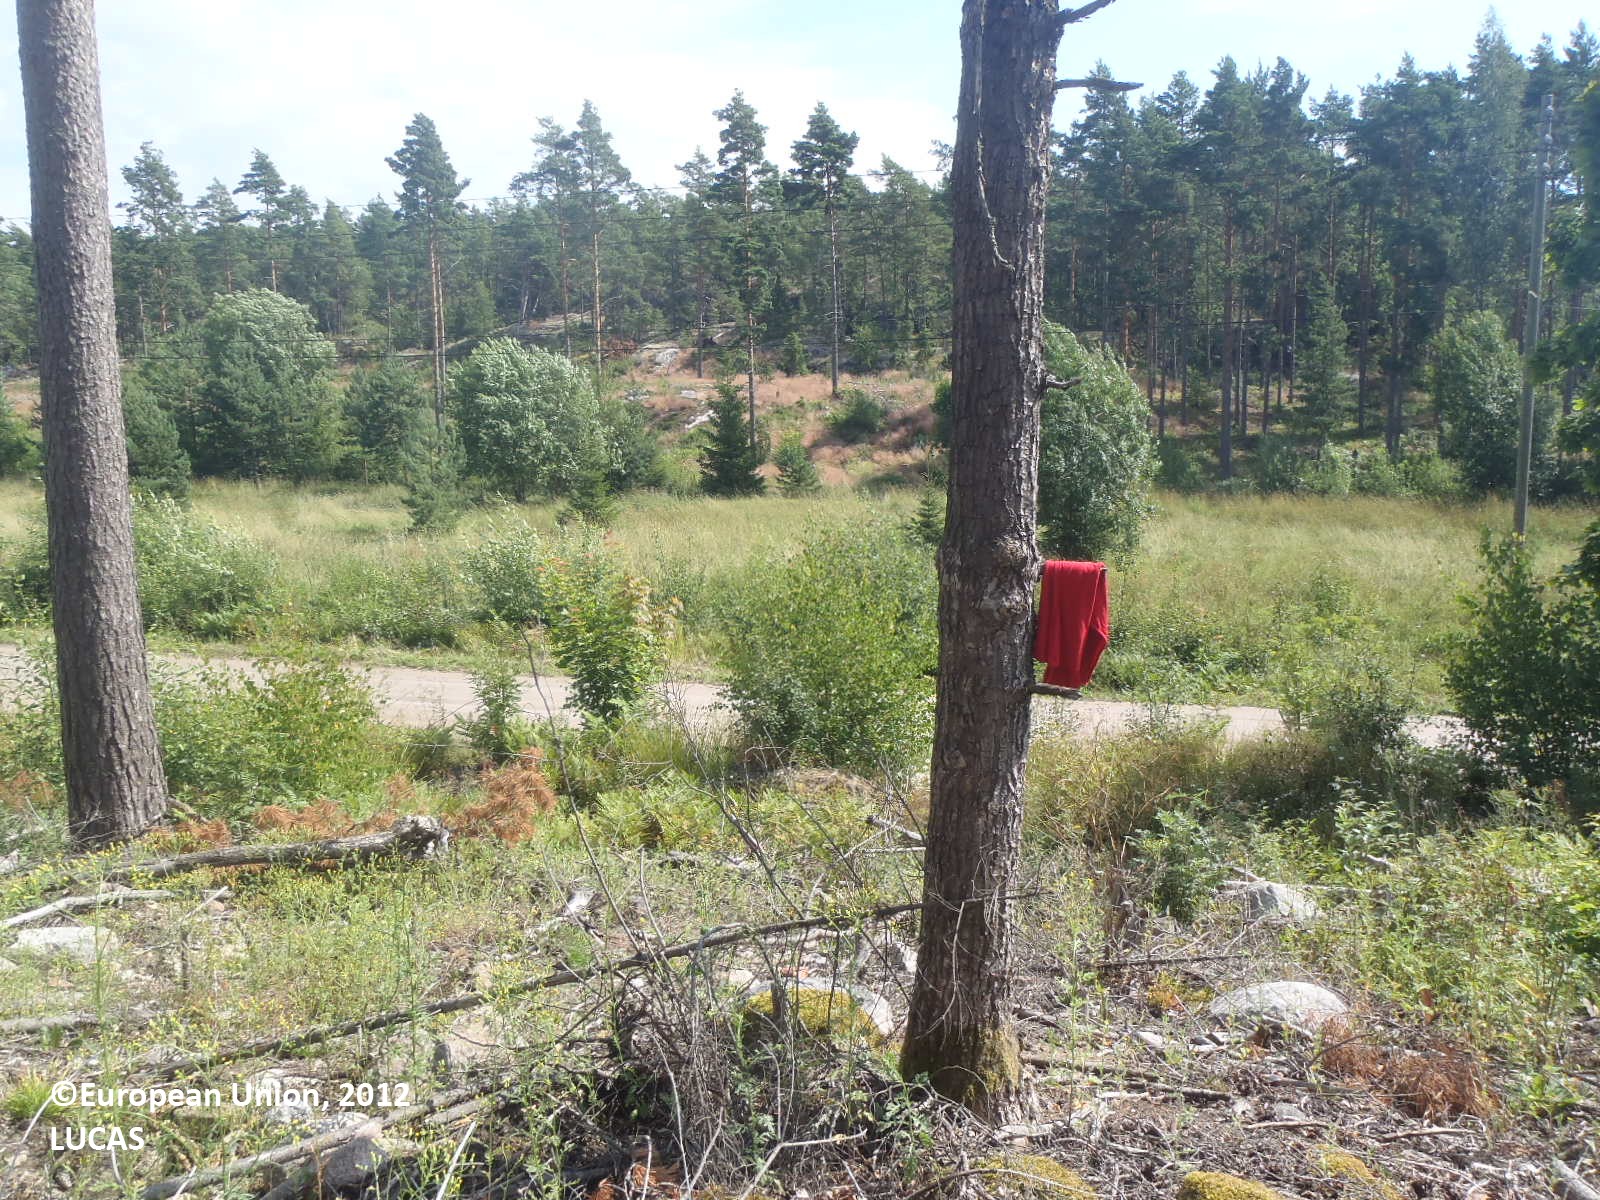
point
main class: Woodland
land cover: Pine dominated mixed woodland
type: boreal forest
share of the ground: 10 - 25 %
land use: Forestry
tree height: > 5 m
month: July
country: FI
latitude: 60.4324
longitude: 21.9997
